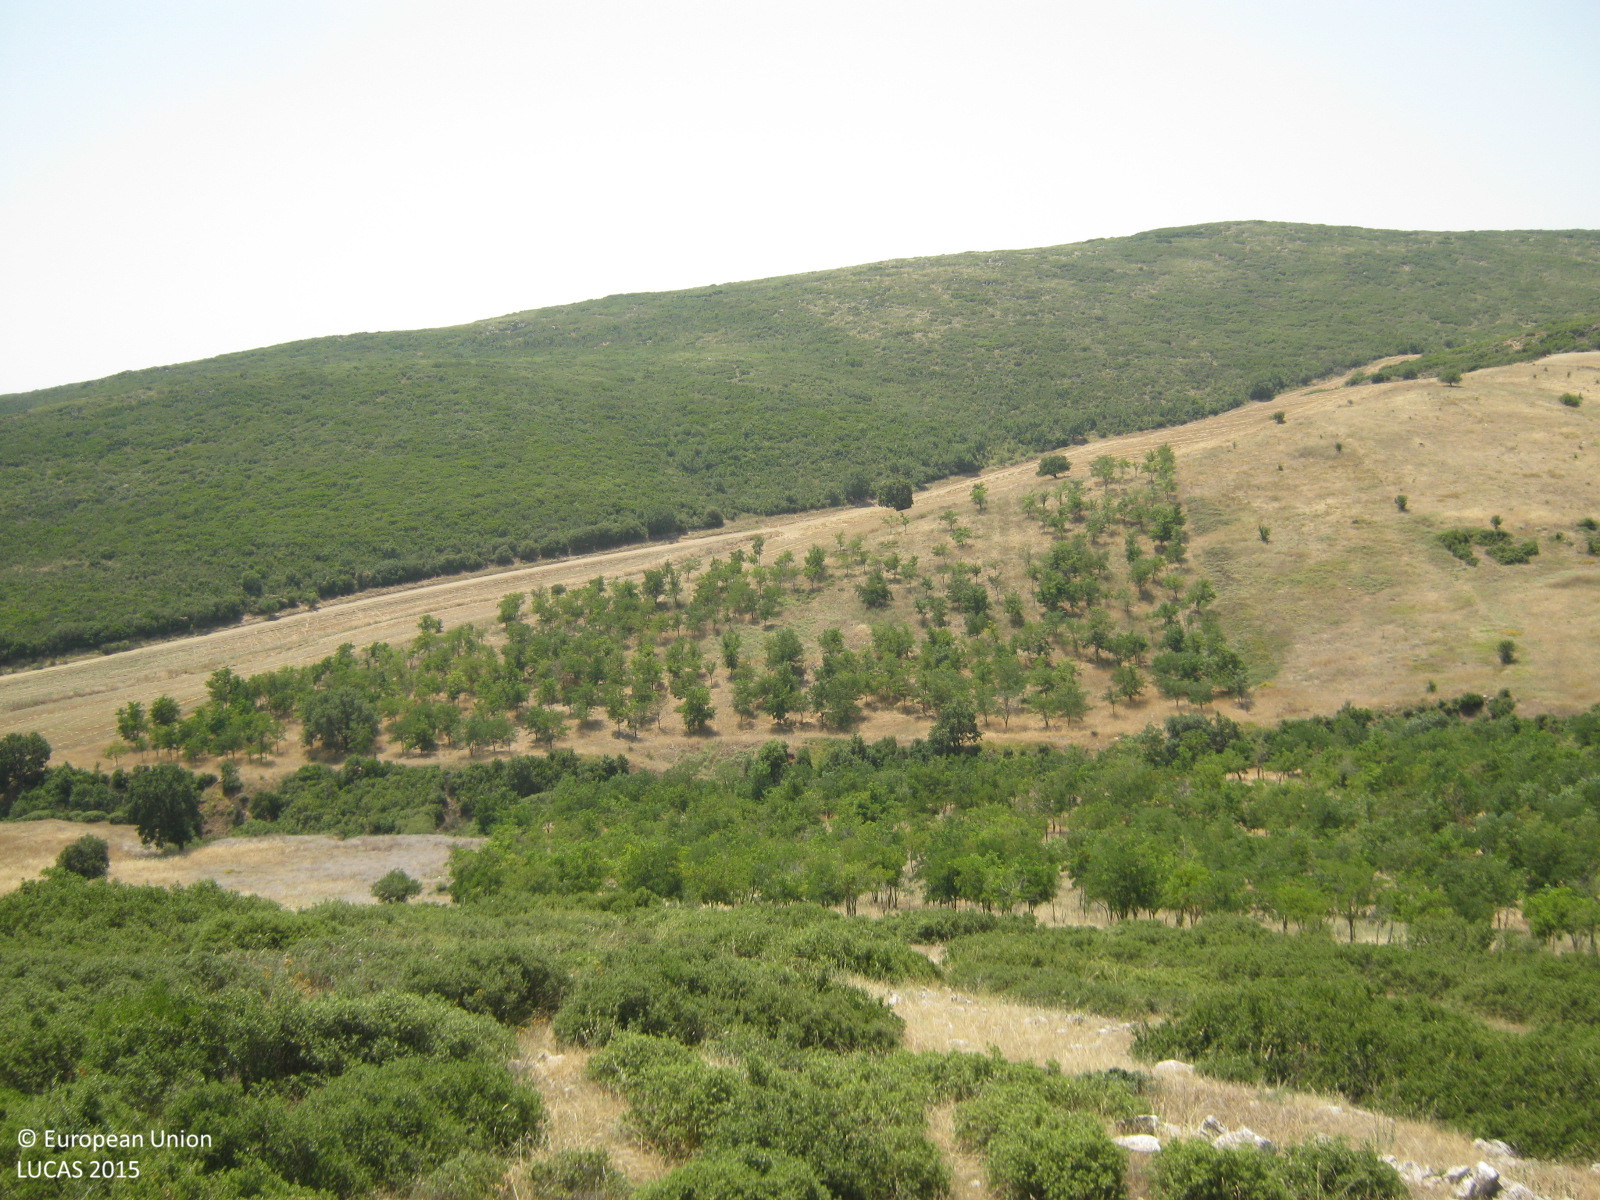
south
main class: Shrubland
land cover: Shrubland without tree cover
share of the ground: 50 - 75 %
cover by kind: shrubs 70 %, unconsolidated bare surface 20 %, herbaceous plants 10 %
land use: Abandoned areas
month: July
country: GR
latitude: 39.2971
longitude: 22.6615
